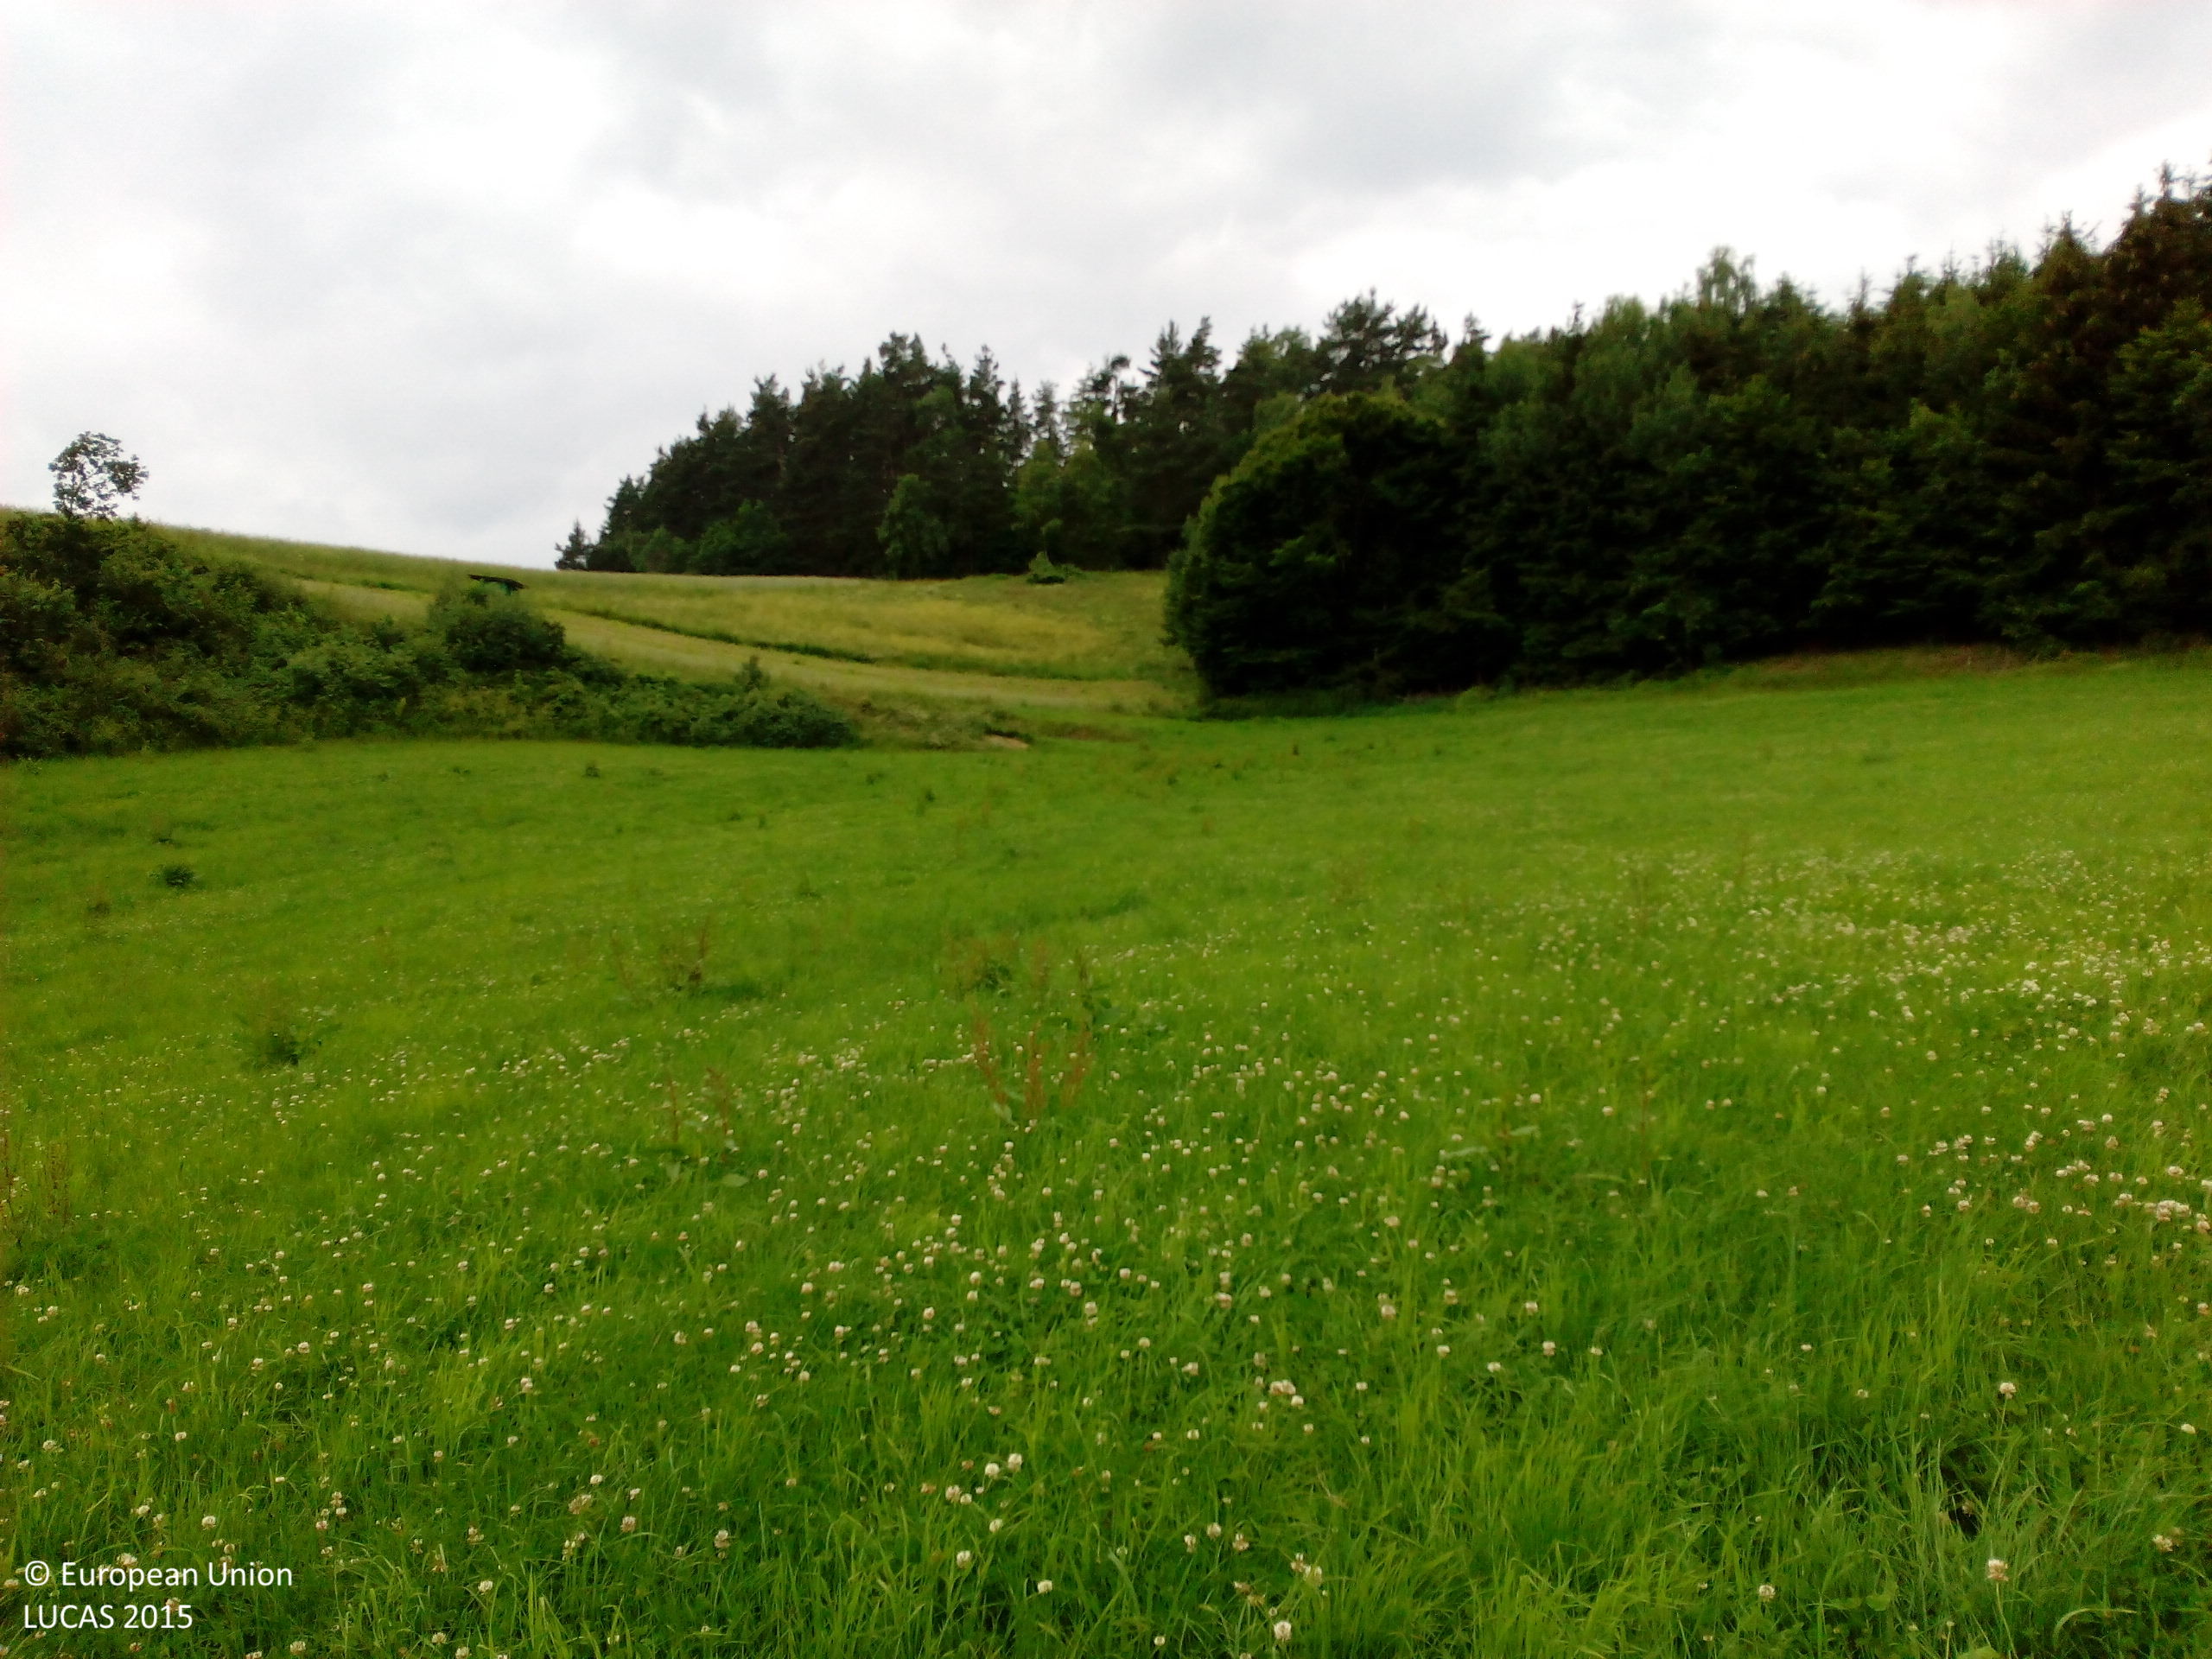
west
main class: Grassland
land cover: Grassland without tree/shrub cover
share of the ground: > 75 %
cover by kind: herbaceous plants 100 %
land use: Agriculture (excluding fallow land and kitchen gardens)
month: June
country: DE
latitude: 49.1149
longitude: 12.4244
